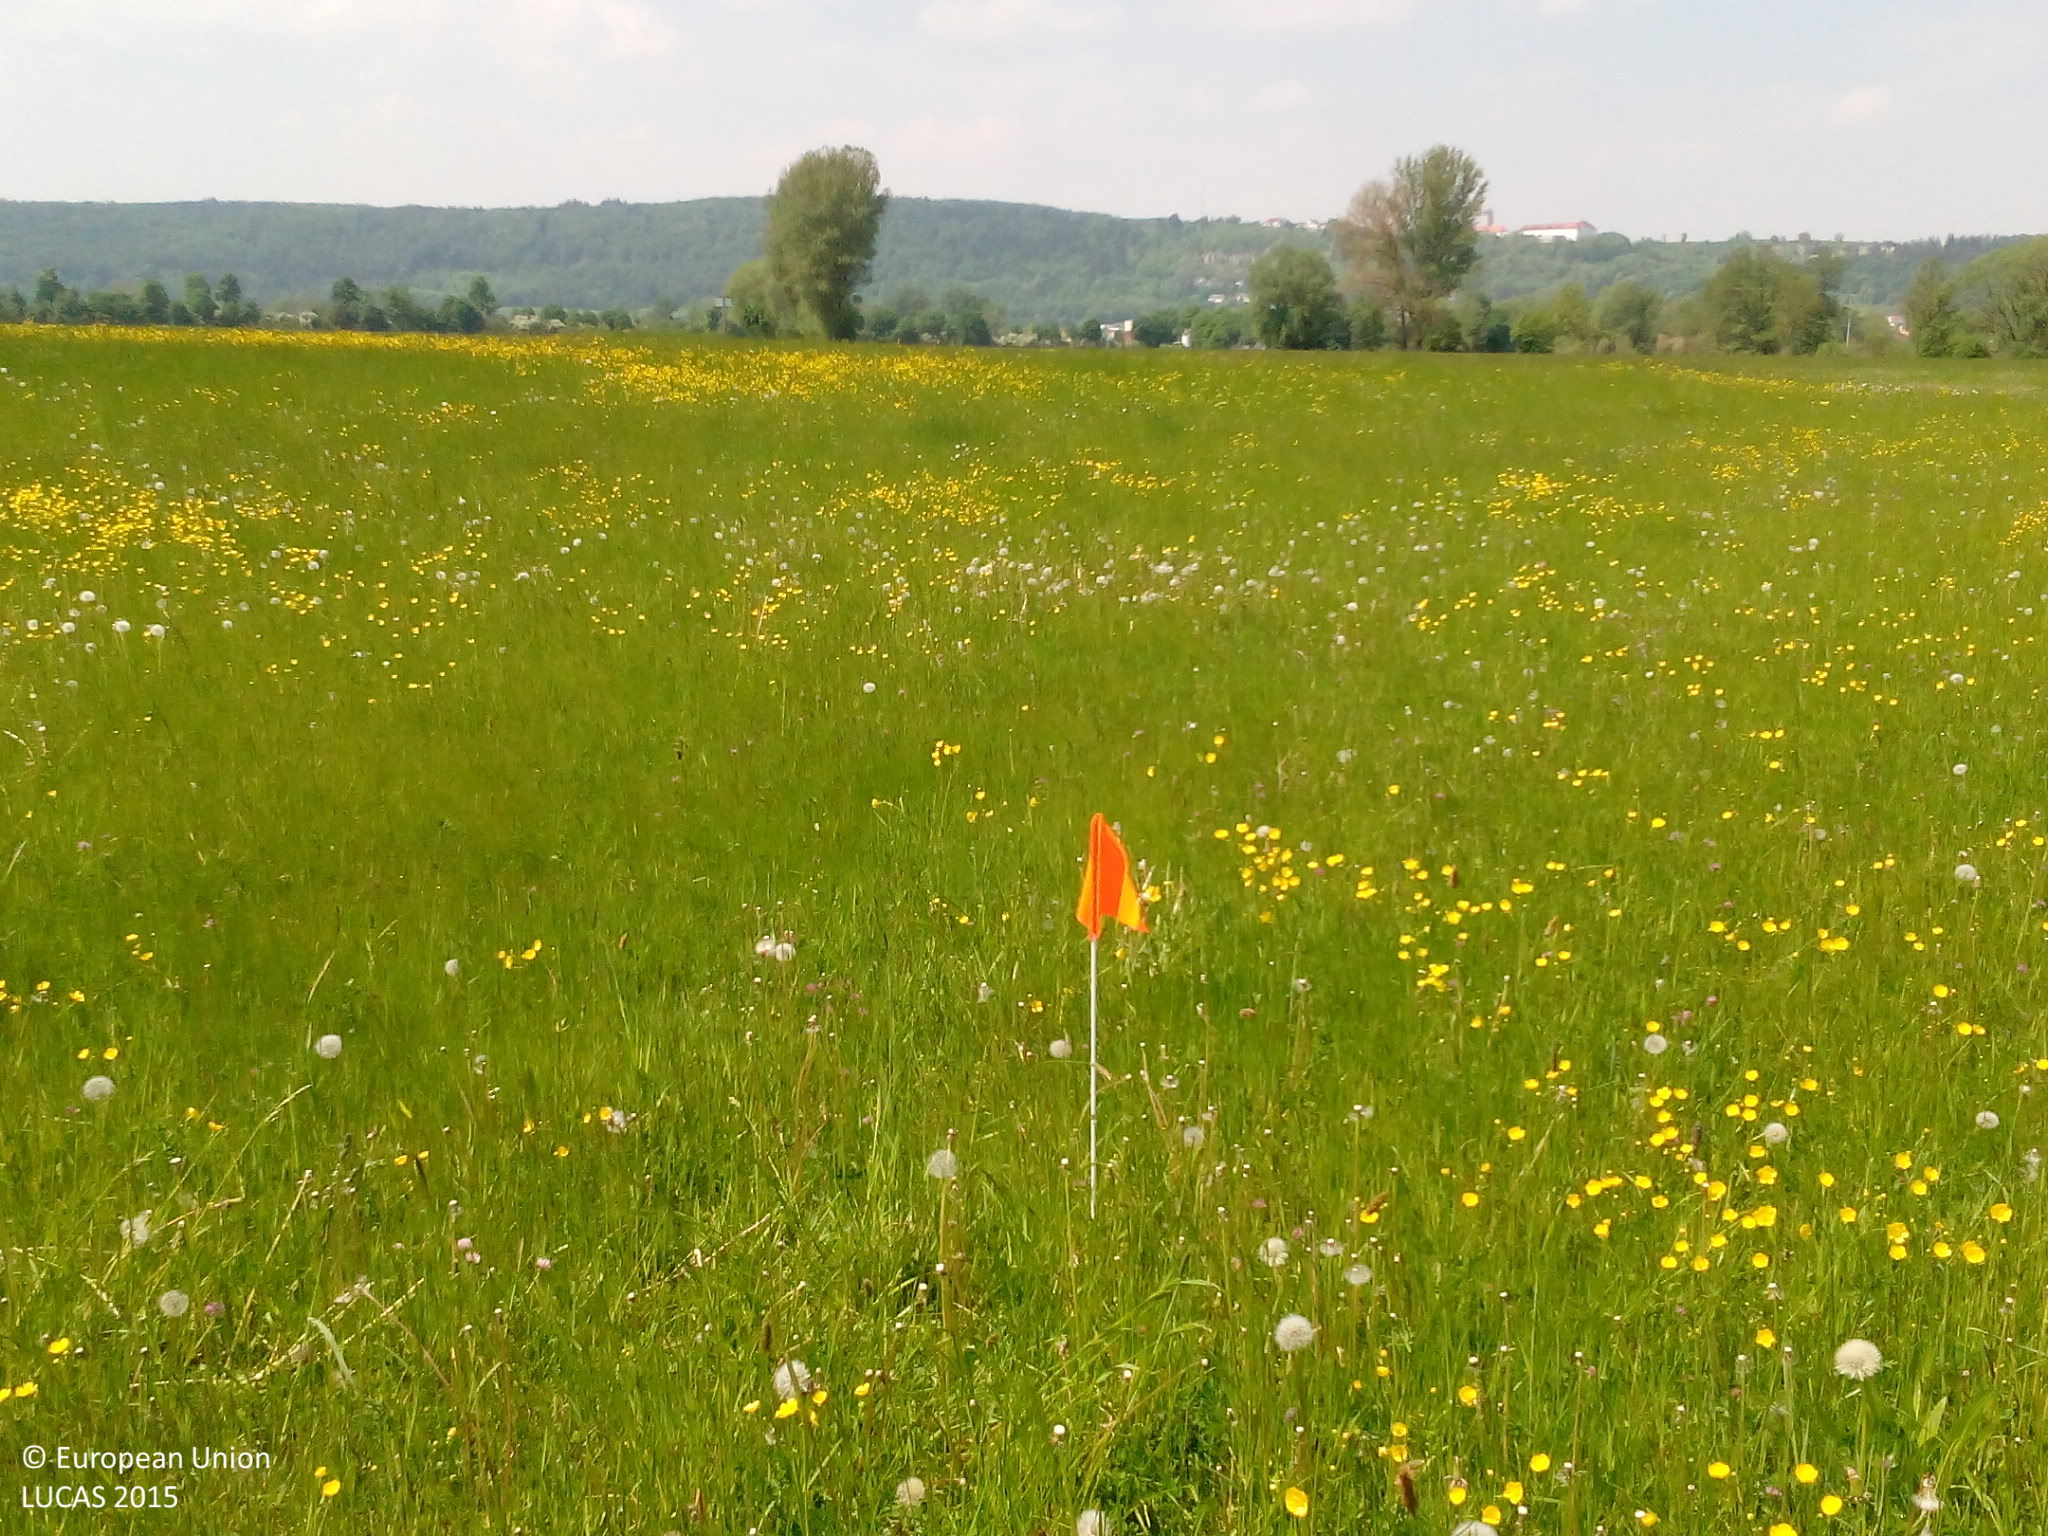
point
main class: Grassland
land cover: Grassland without tree/shrub cover
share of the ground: > 75 %
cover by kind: herbaceous plants 95 %, lichens and mosses 5 %
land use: Agriculture (excluding fallow land and kitchen gardens)
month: May
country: DE
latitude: 49.0232
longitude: 11.4900
